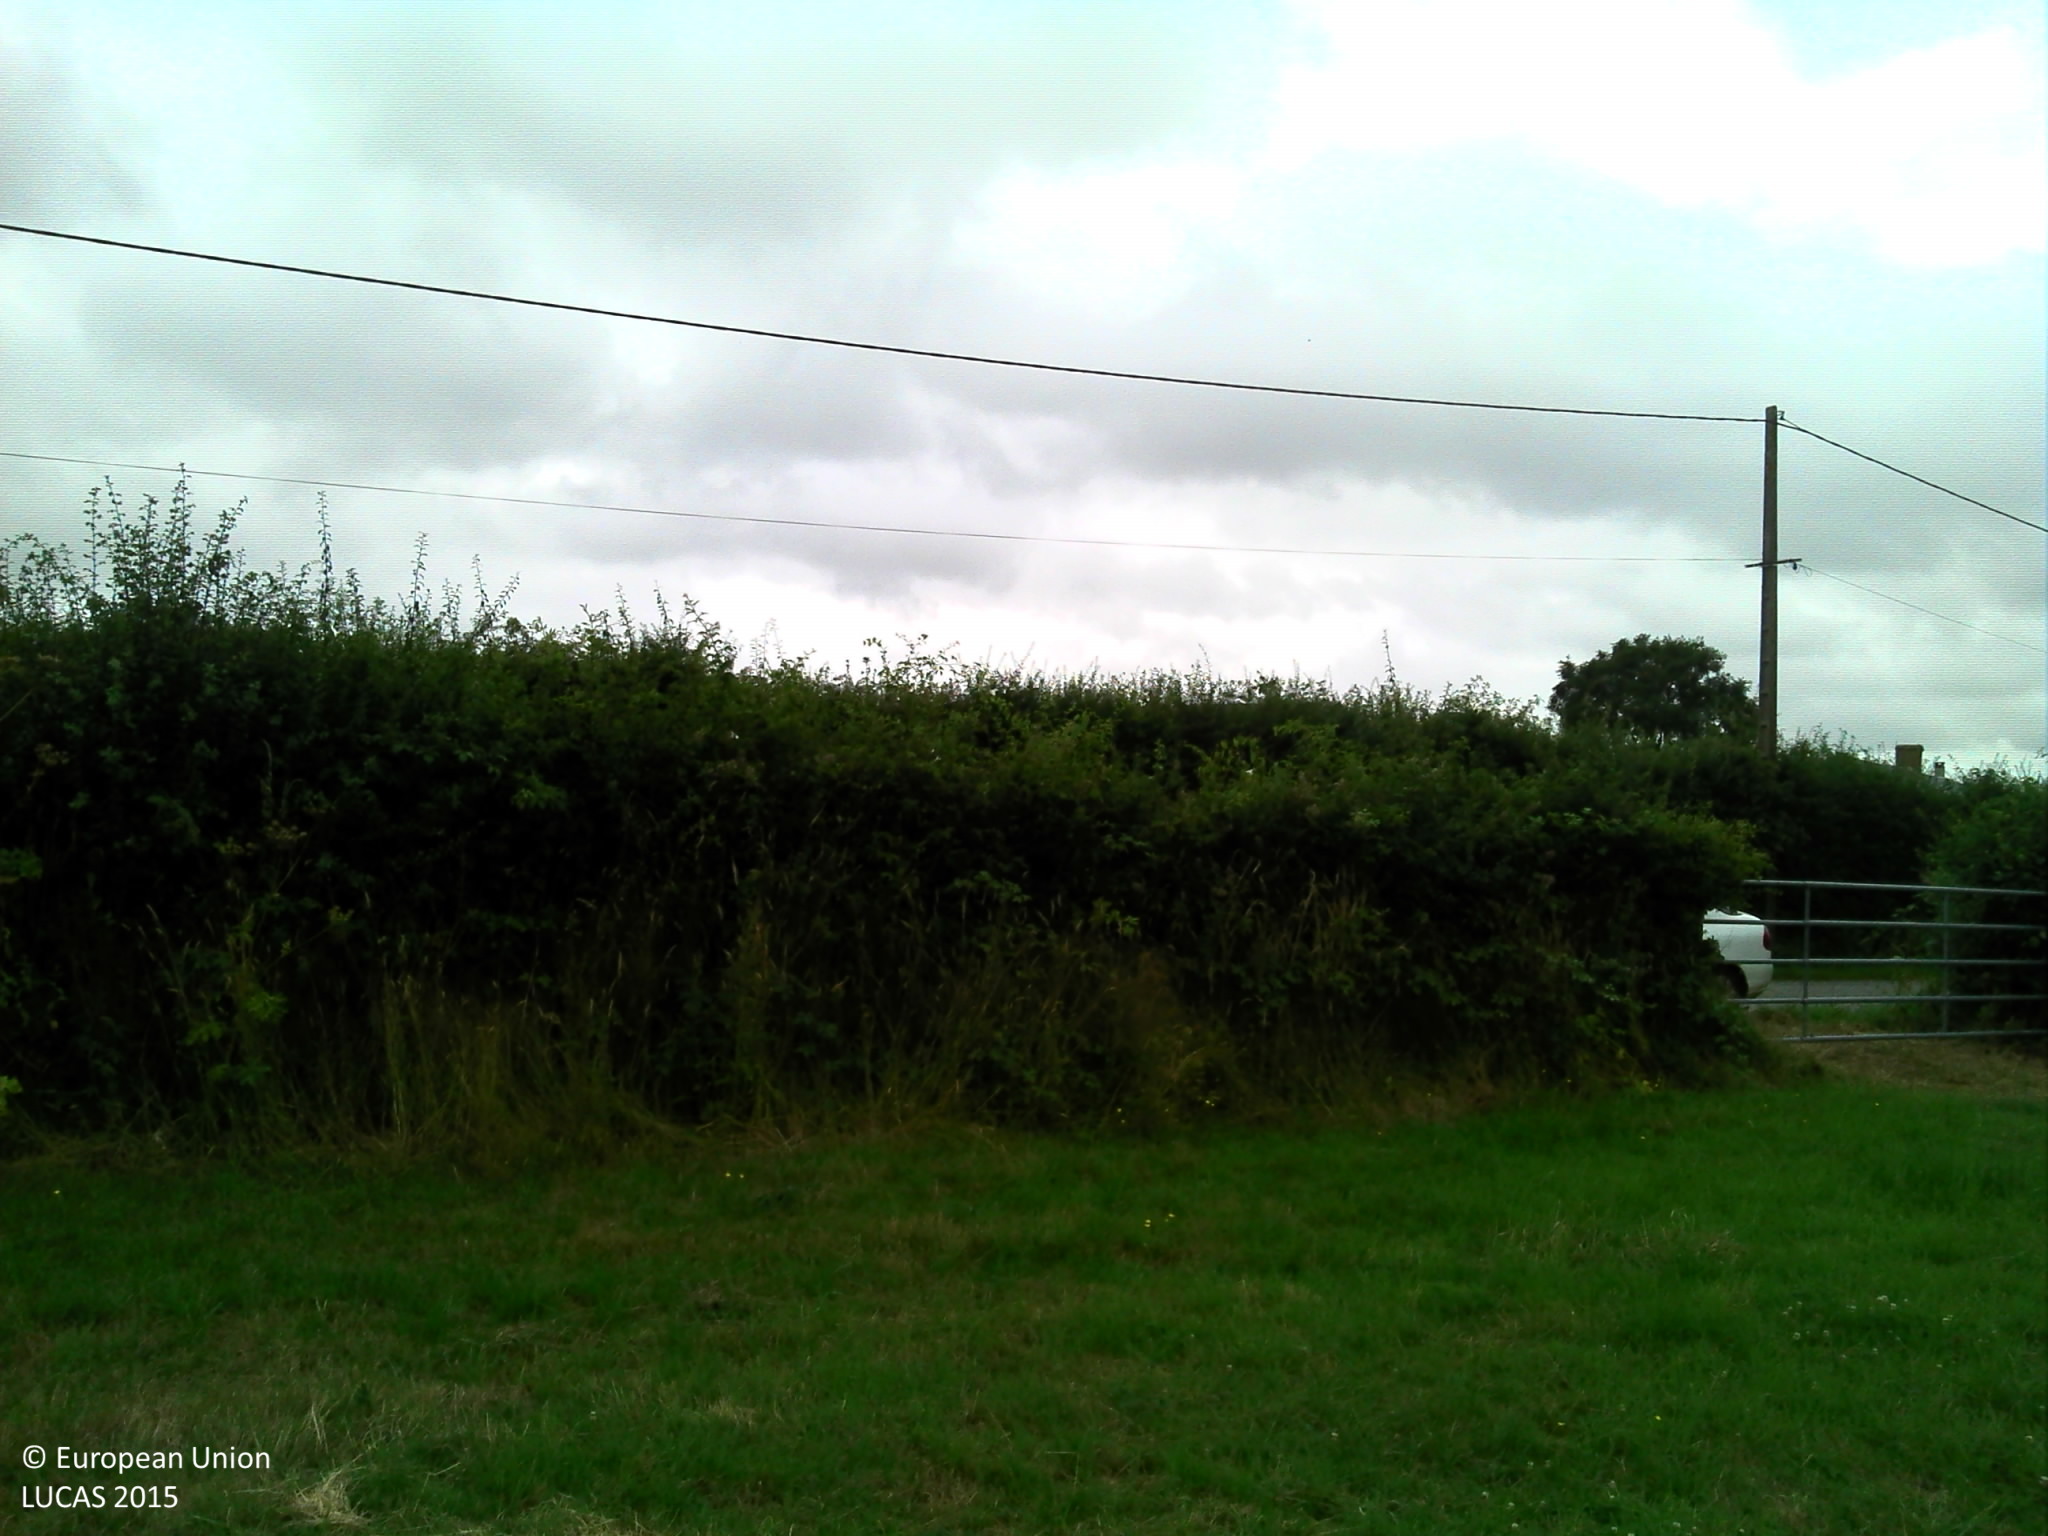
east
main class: Grassland
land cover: Grassland without tree/shrub cover
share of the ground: > 75 %
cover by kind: herbaceous plants 100 %
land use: Agriculture (excluding fallow land and kitchen gardens)
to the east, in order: Grassland without tree/shrub cover; Managed hedges; Fences; Ditches and canals; Grass margins; Paved roads, cycling and walking lanes; Grass margins; Ditches and canals; Electric lines; Managed hedges; Grassland without tree/shrub cover; Fences; Grassland without tree/shrub cover; Artificial constructions in urban areas; Lines of trees; Grassland without tree/shrub cover; Lines of trees; Grassland without tree/shrub cover; Fences; Broadleaved woodland; Grassland without tree/shrub cover
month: July
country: FR
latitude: 48.4221
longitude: -0.1794
